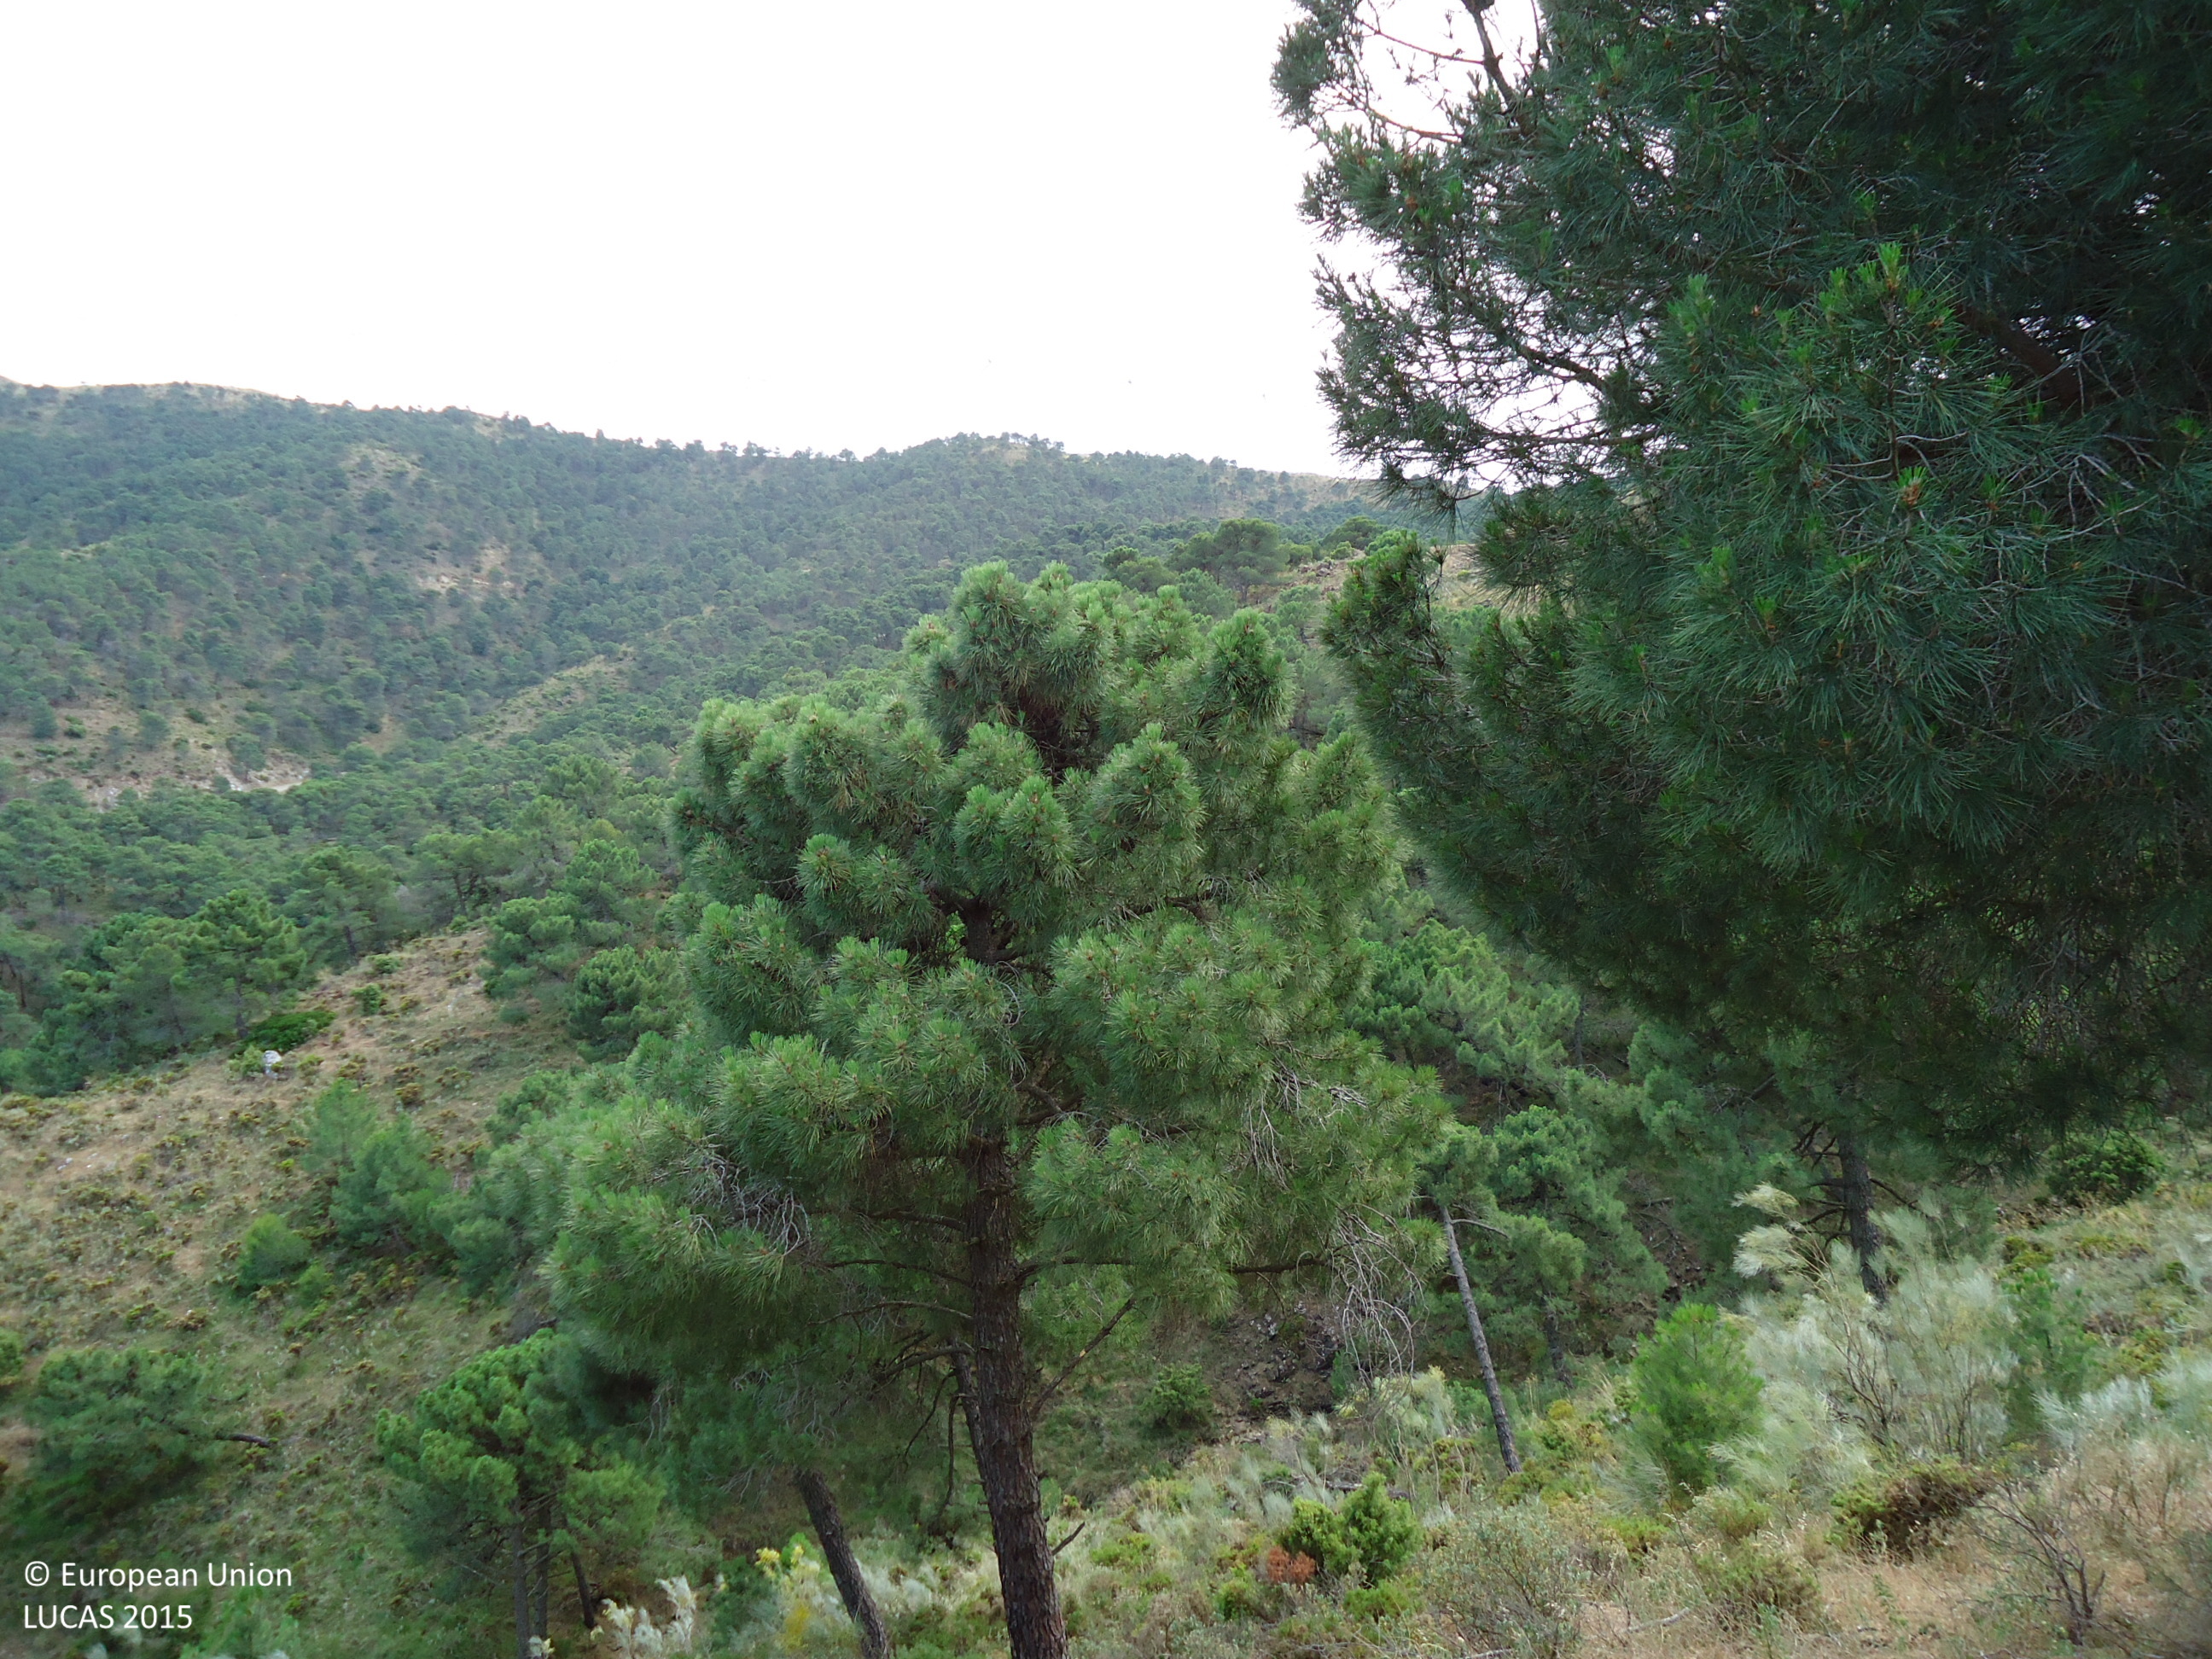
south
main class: Woodland
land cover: Pine dominated coniferous woodland
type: coniferous forest of the mediterranean region
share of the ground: 25 - 50 %
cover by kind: shrubs 75 %, coniferous forest trees 25 %
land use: Forestry
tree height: > 5 m
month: June
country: ES
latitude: 36.8600
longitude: -4.7912
